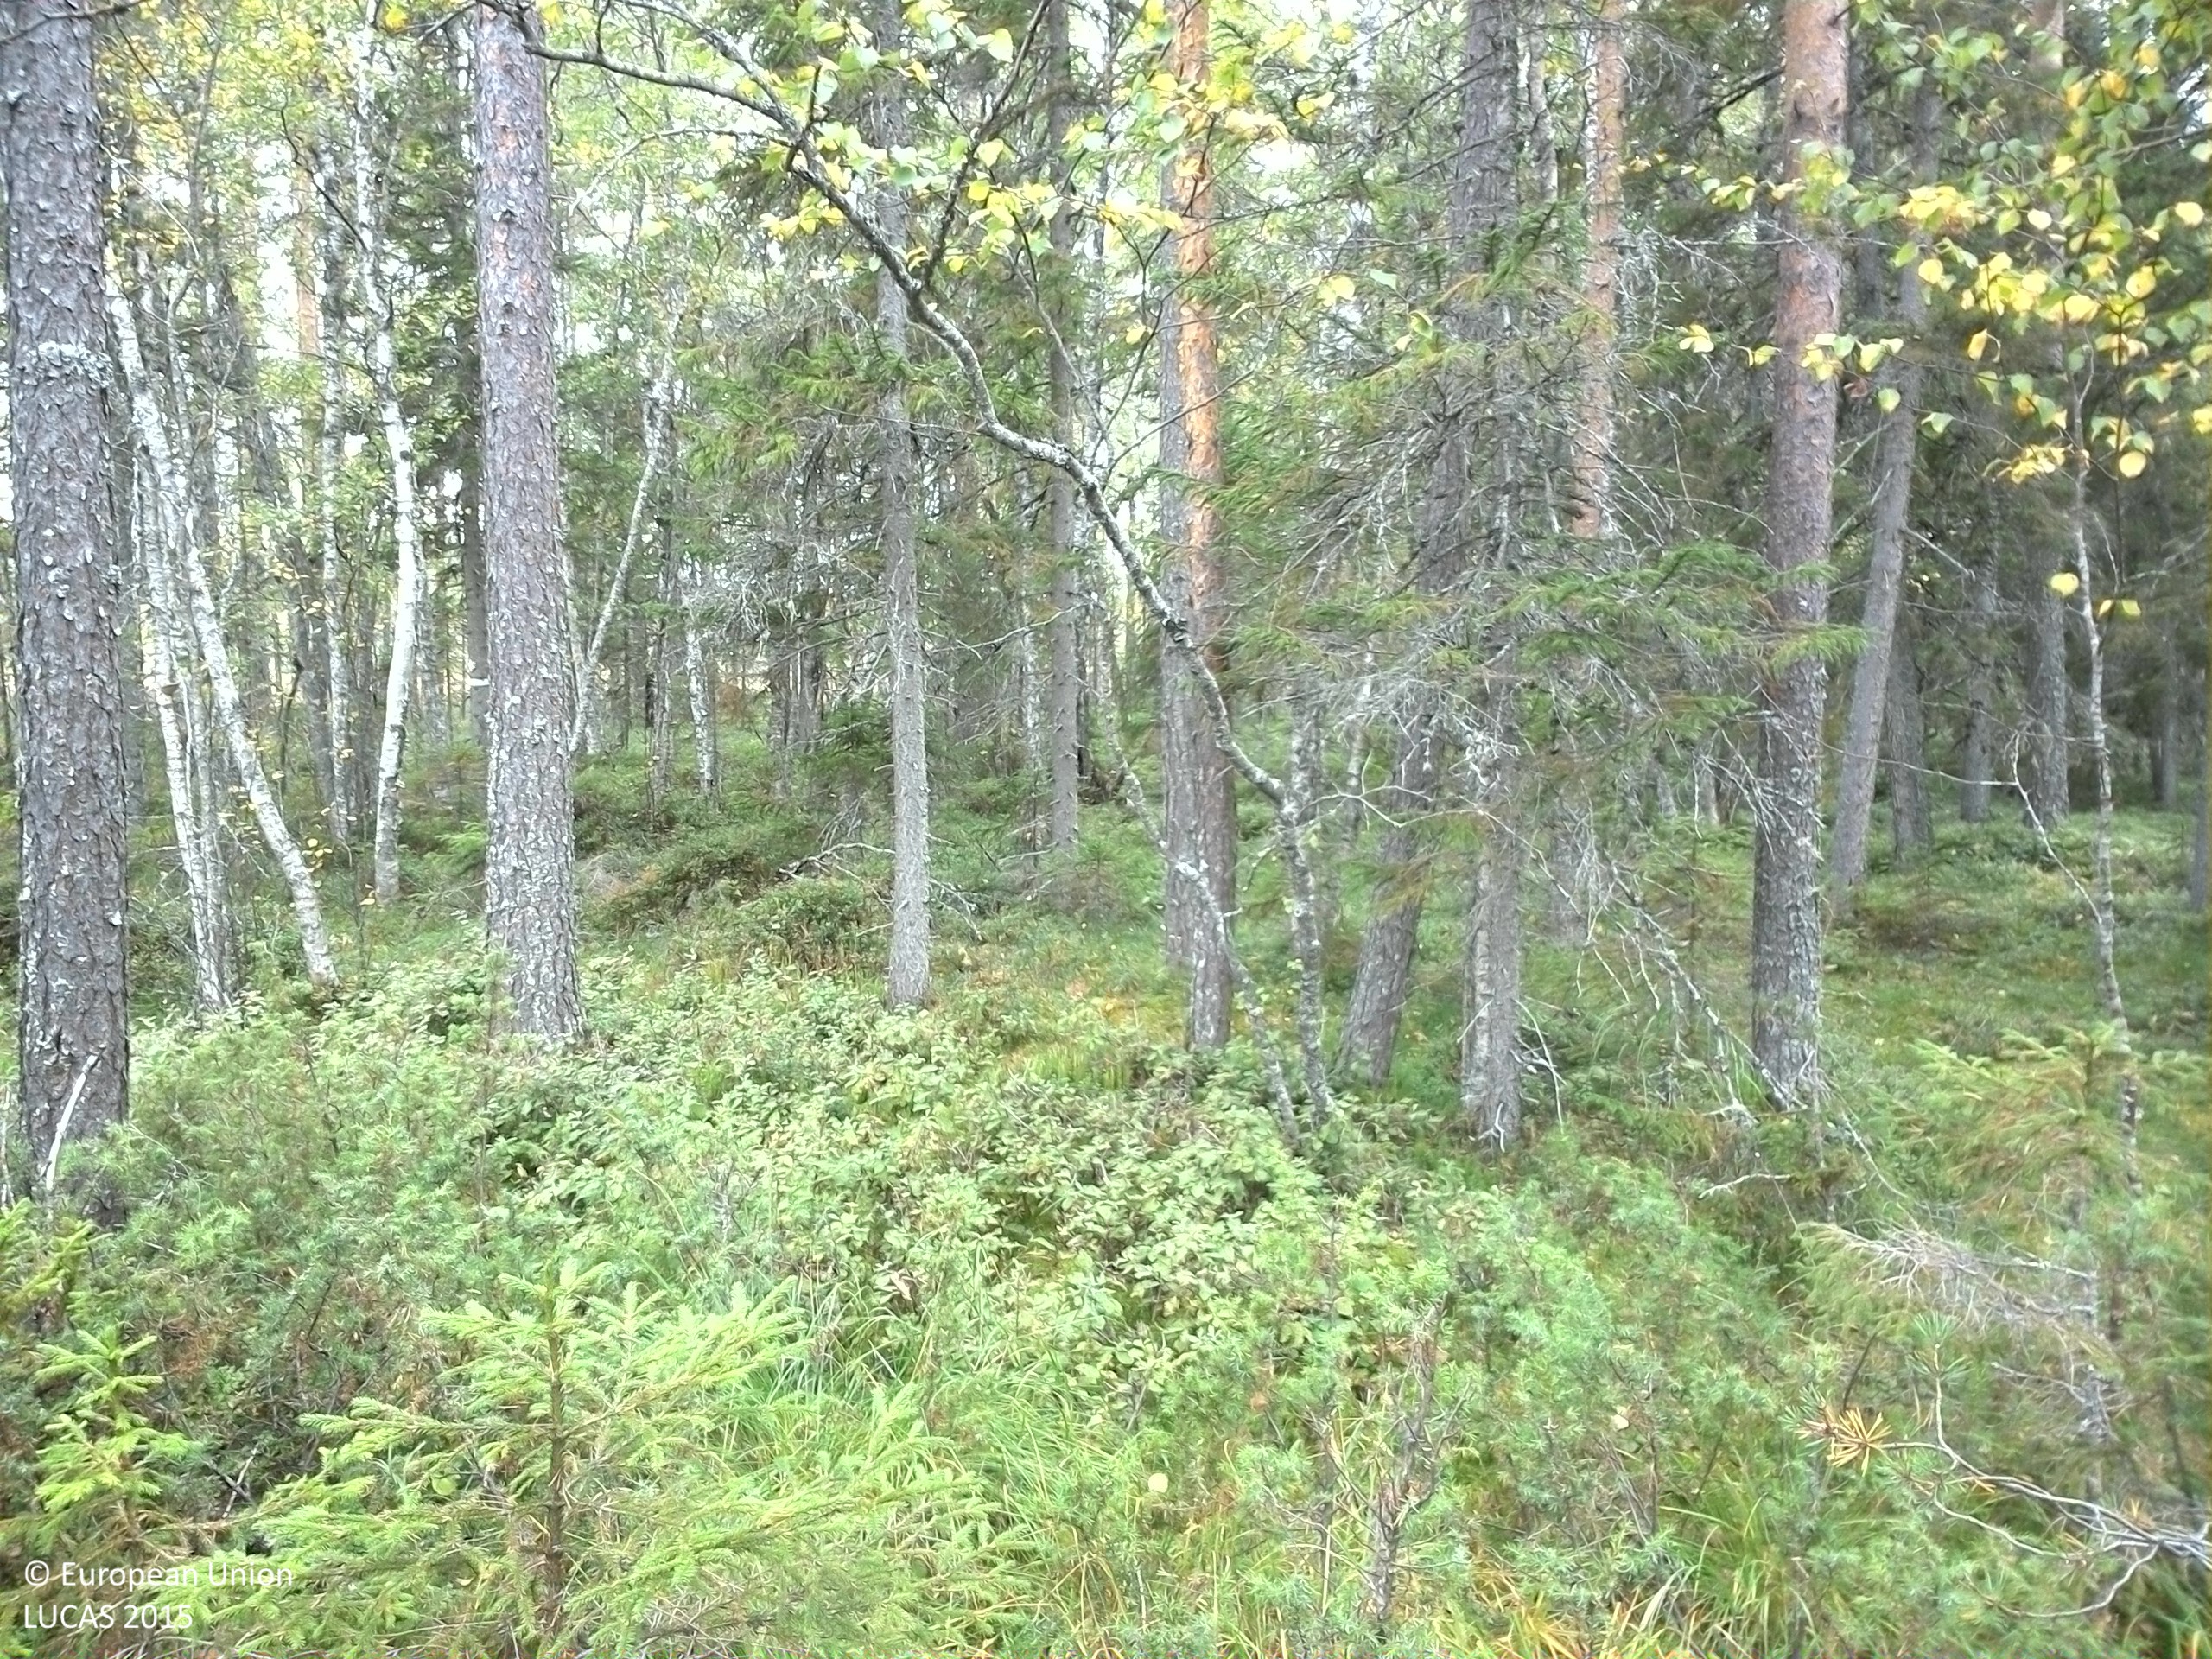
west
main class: Woodland
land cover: Pine dominated mixed woodland
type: boreal forest
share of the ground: 50 - 75 %
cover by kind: coniferous forest trees 45 %, broadleaved forest trees 20 %, lichens and mosses 20 %, shrubs 15 %
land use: Forestry
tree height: > 5 m
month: September
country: SE
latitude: 61.5485
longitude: 15.1584
